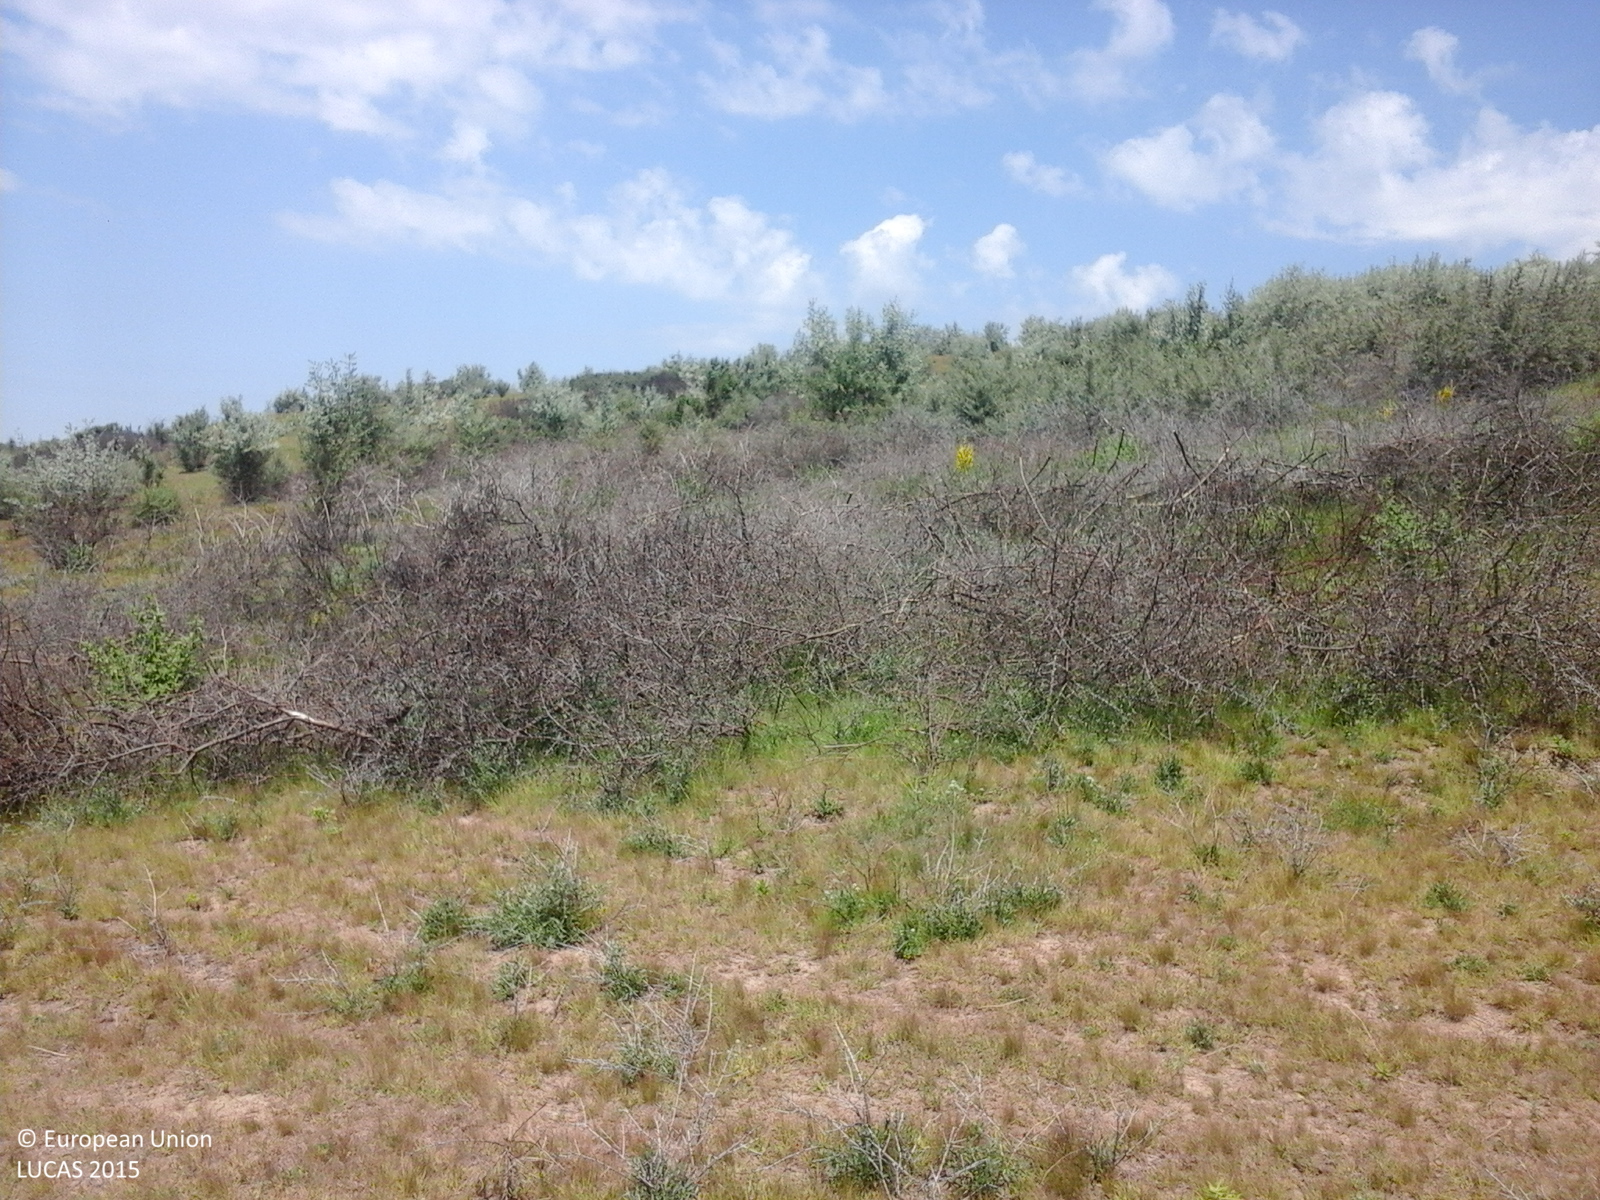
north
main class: Grassland
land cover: Grassland without tree/shrub cover
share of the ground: > 75 %
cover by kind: herbaceous plants 100 %
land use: Agriculture (excluding fallow land and kitchen gardens)
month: June
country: RO
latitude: 46.6662
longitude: 27.9134
